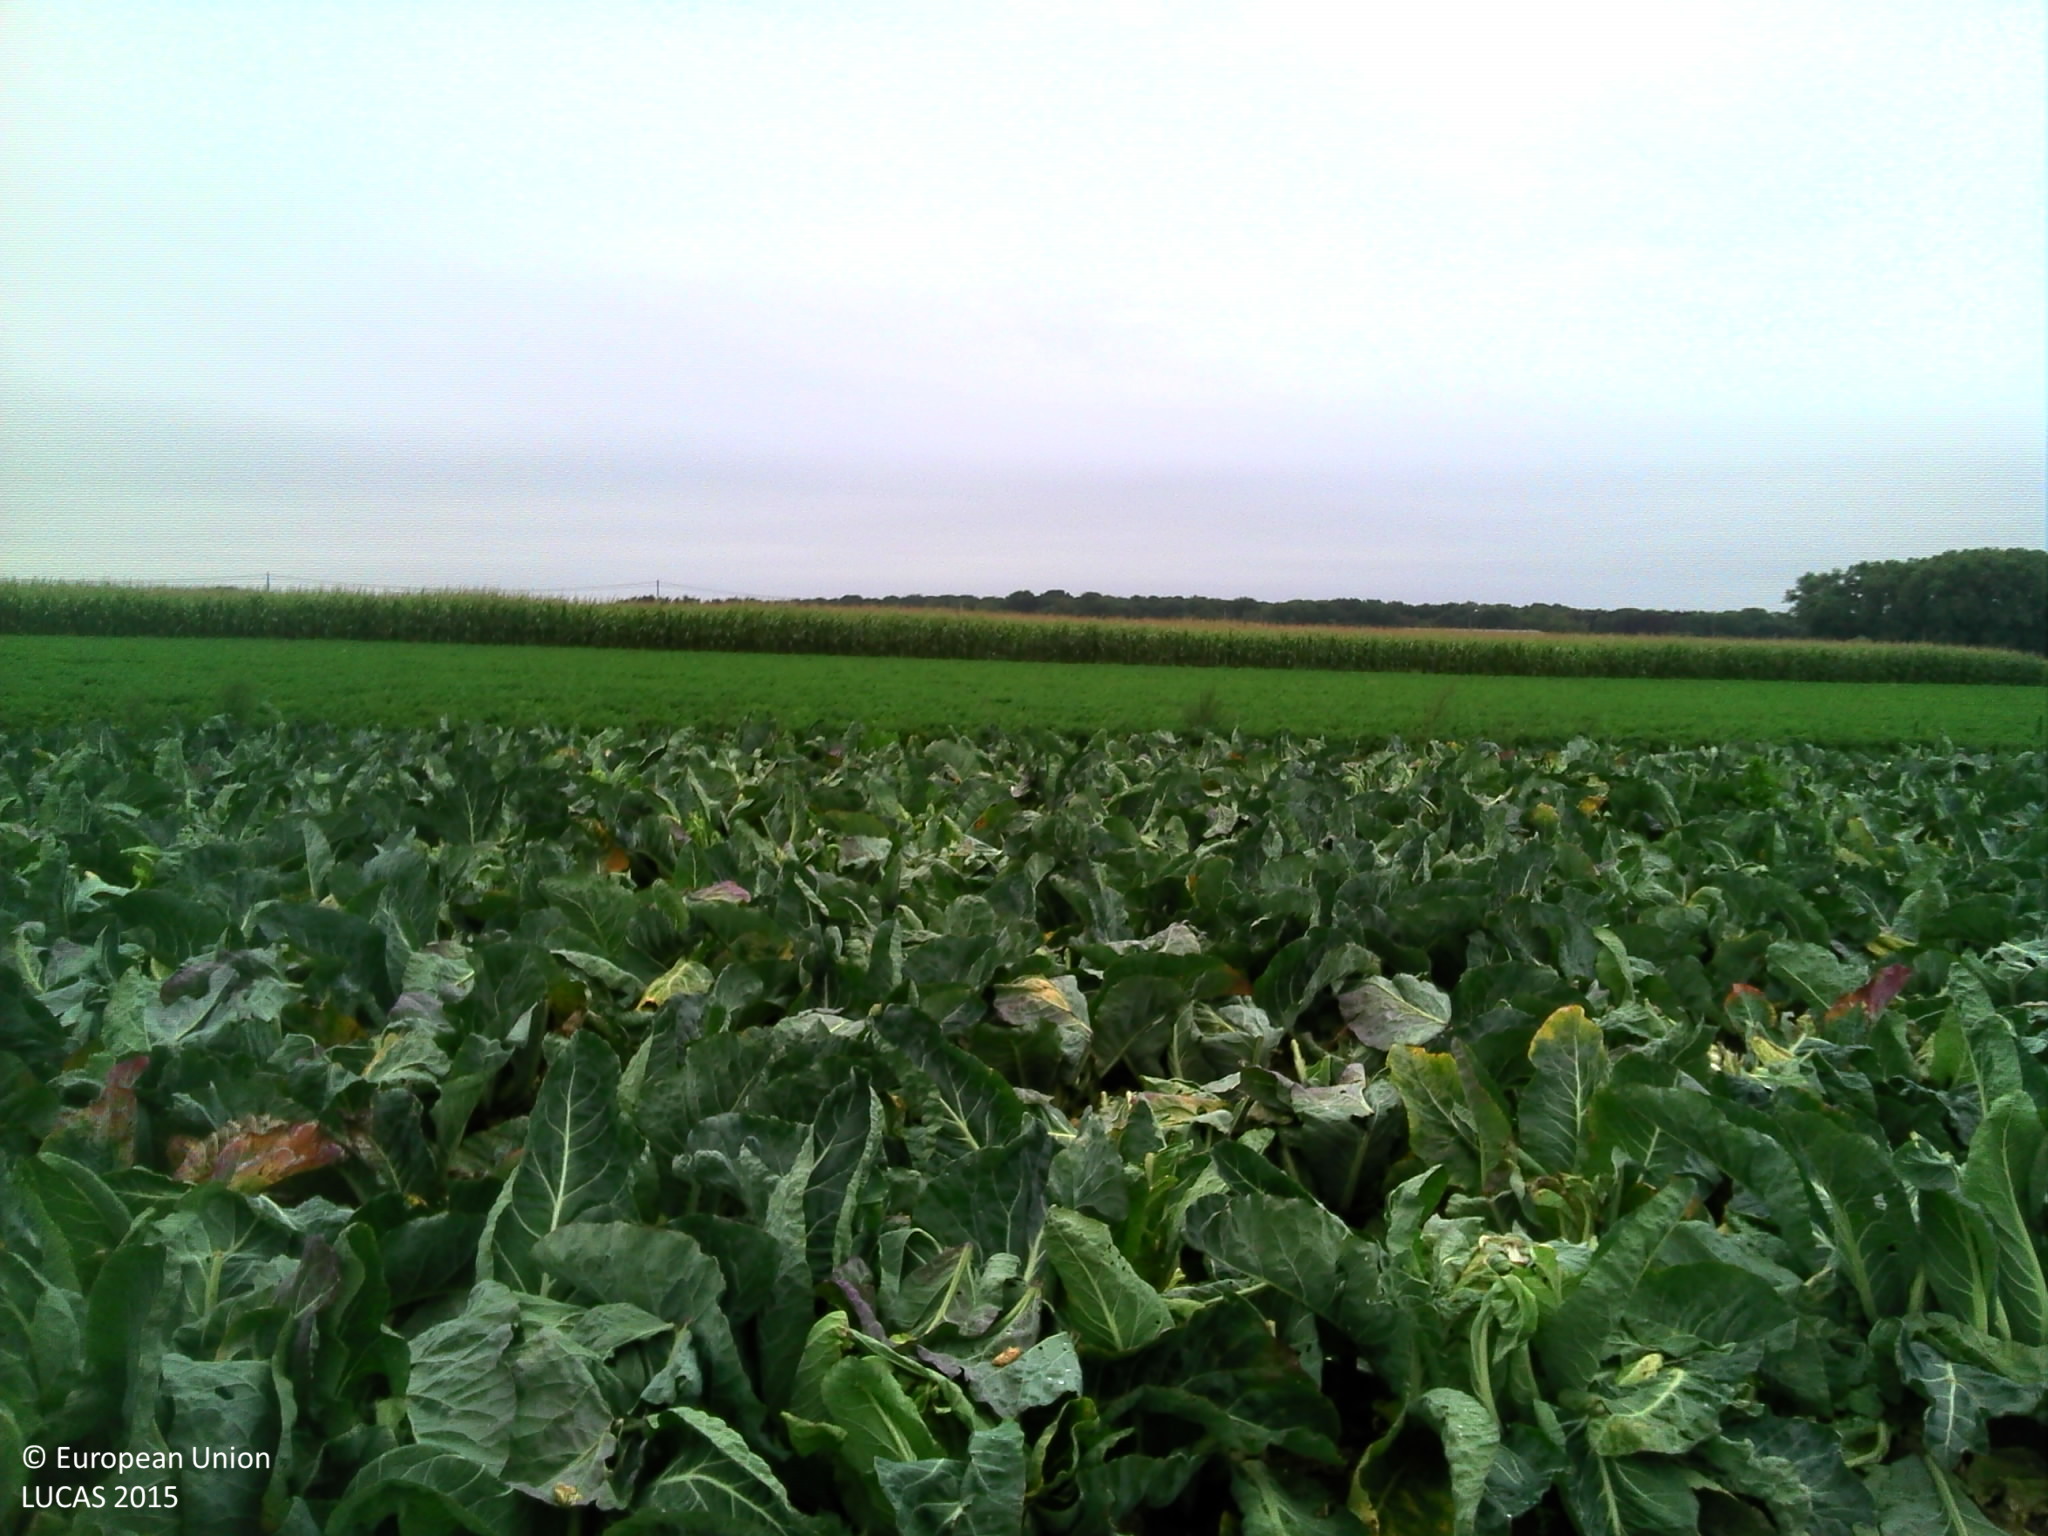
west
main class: Cropland
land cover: Other fresh vegetables
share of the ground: > 75 %
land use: Agriculture (excluding fallow land and kitchen gardens)
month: September
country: BE
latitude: 51.0690
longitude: 2.9828
